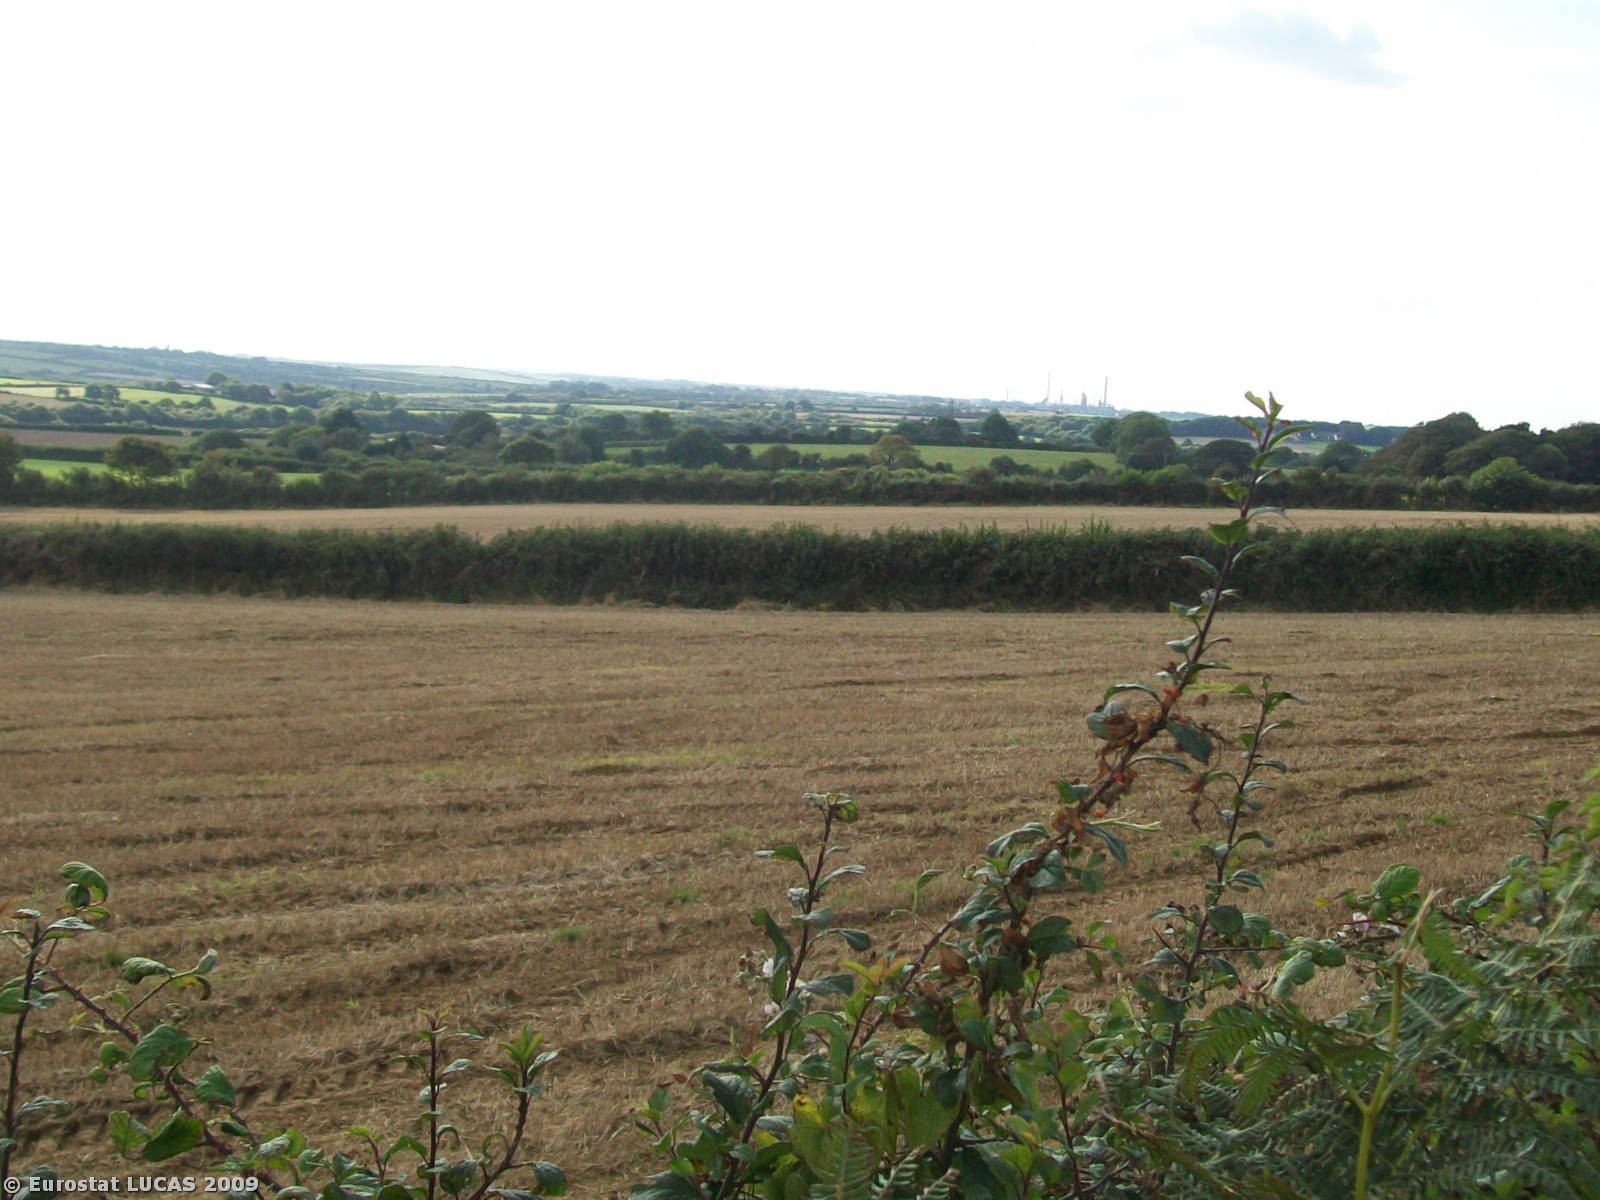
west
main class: Cropland
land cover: Common wheat
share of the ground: 10 - 25 %
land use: Agriculture (excluding fallow land and kitchen gardens)
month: September
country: GB
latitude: 51.7509
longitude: -4.9637
